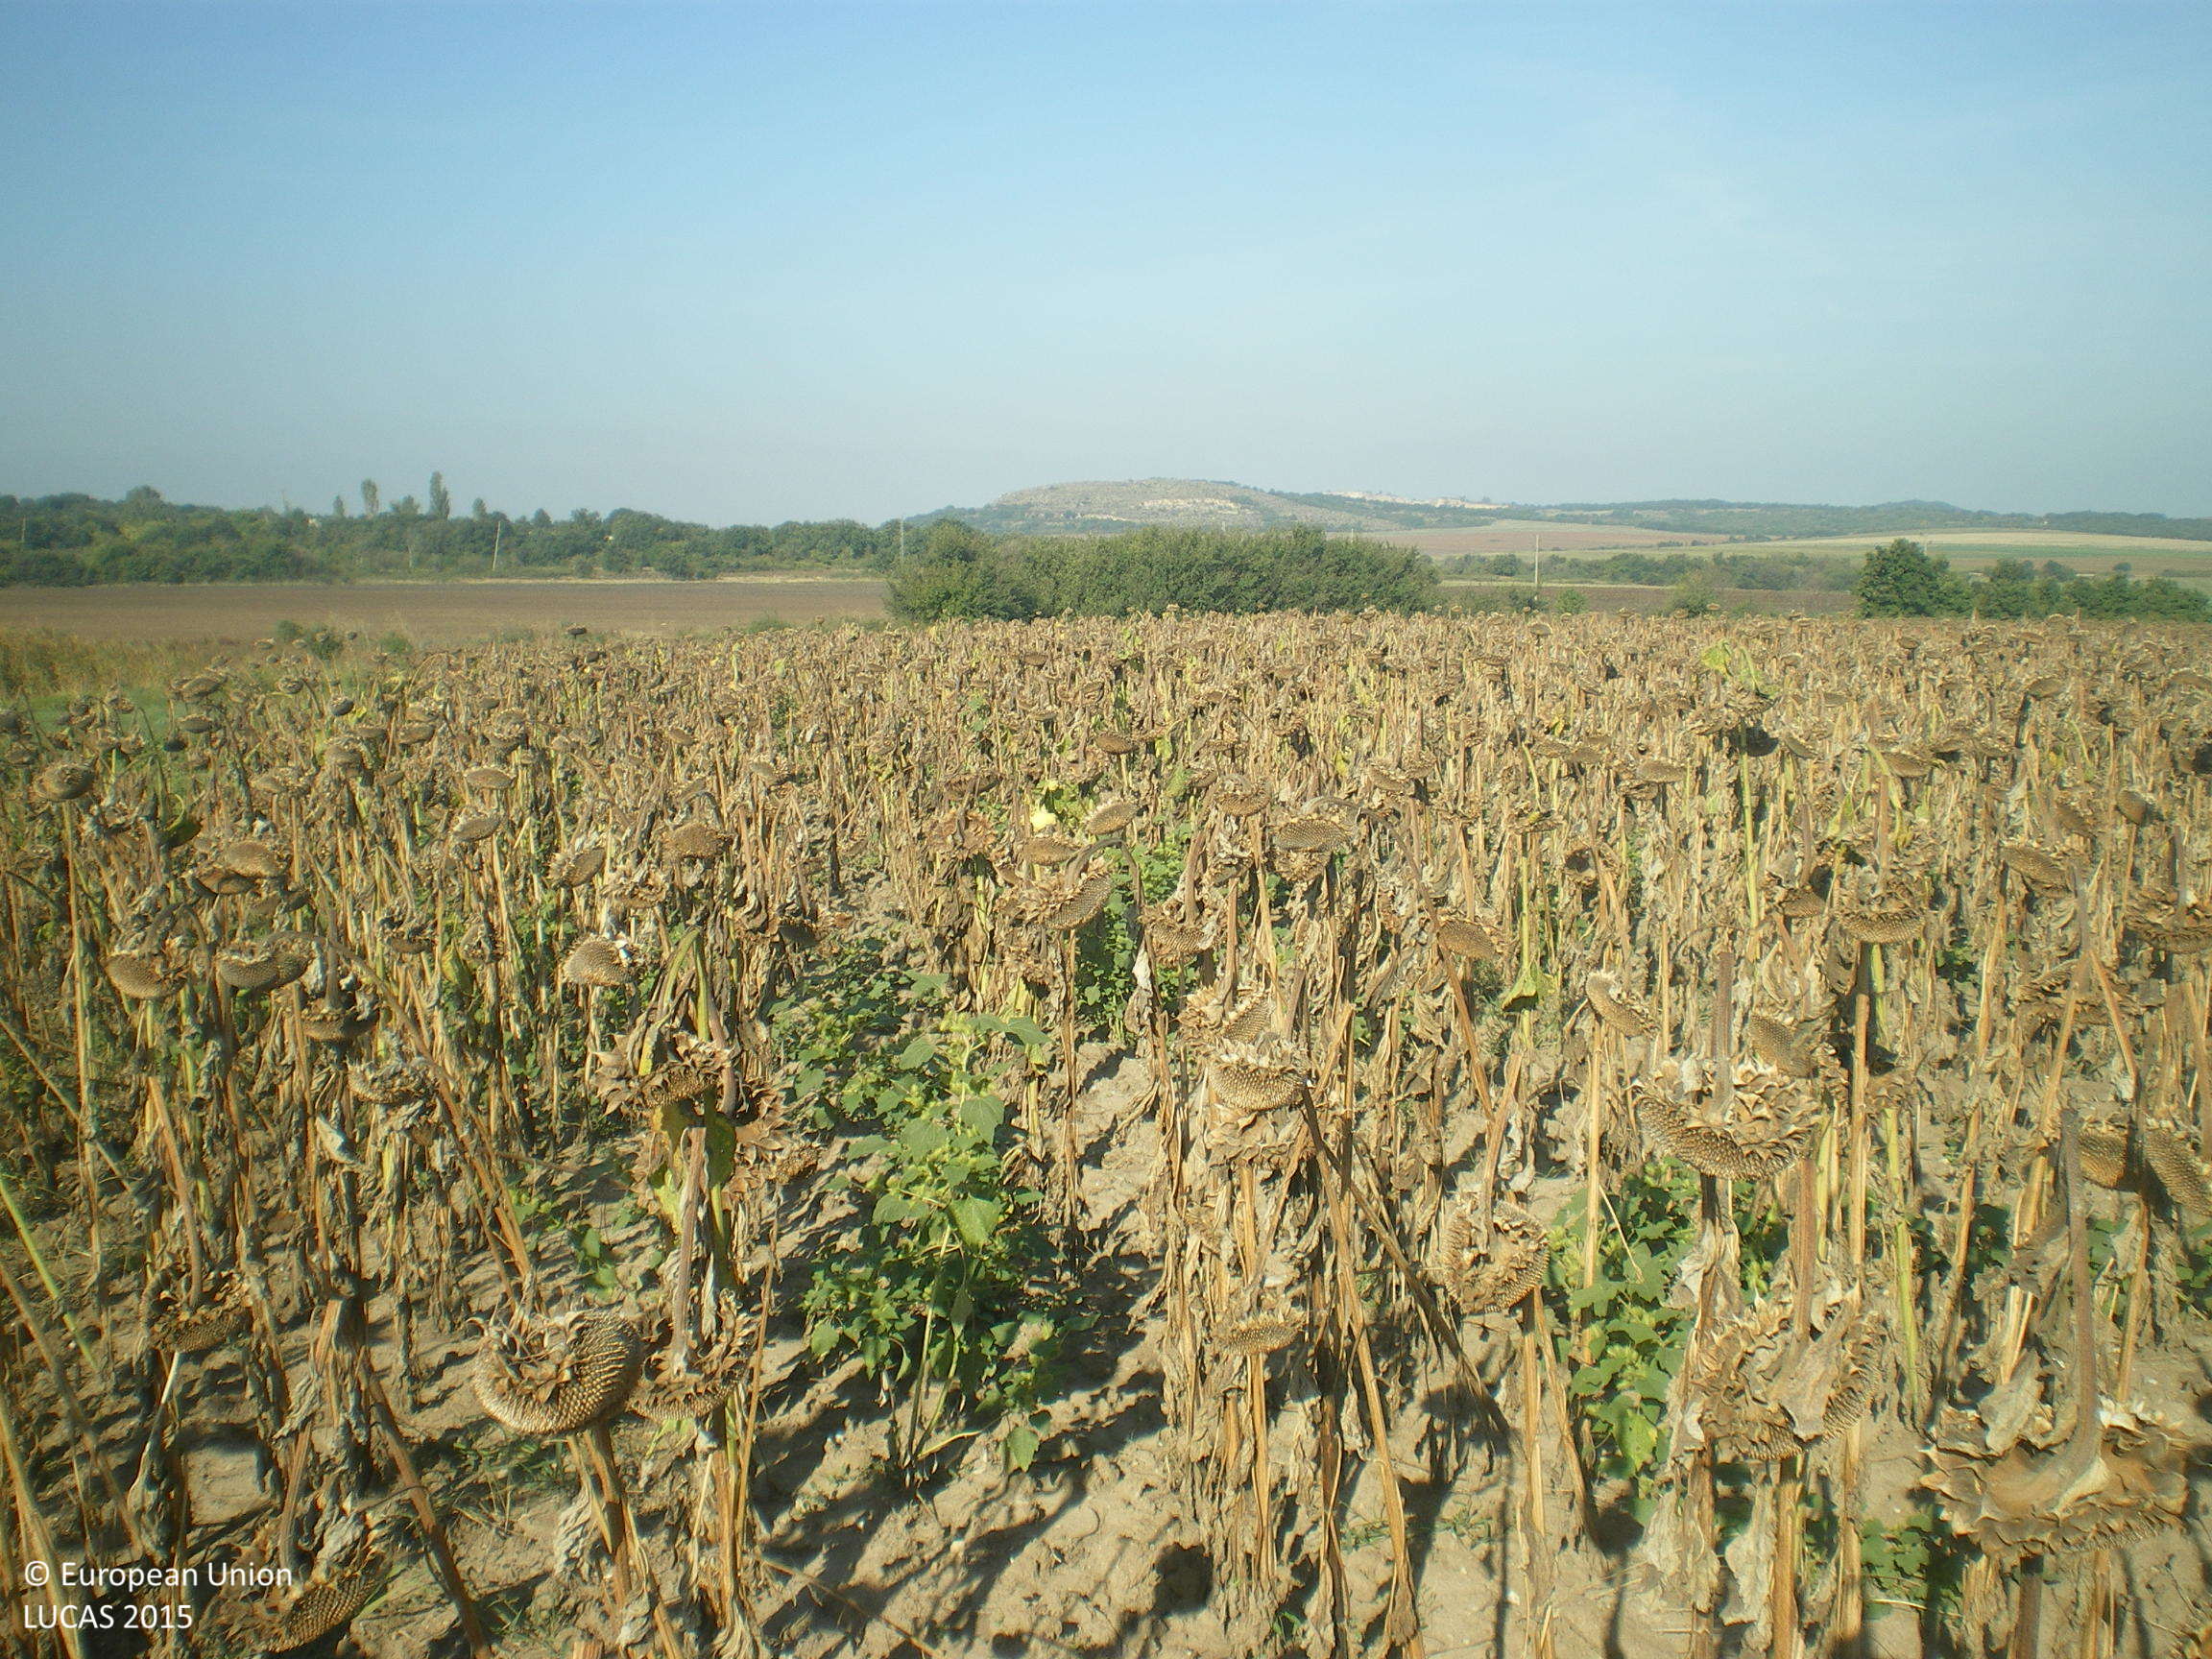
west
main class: Cropland
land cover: Sunflower
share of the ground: > 75 %
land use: Agriculture (excluding fallow land and kitchen gardens)
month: September
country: BG
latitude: 41.9837
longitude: 25.6242
